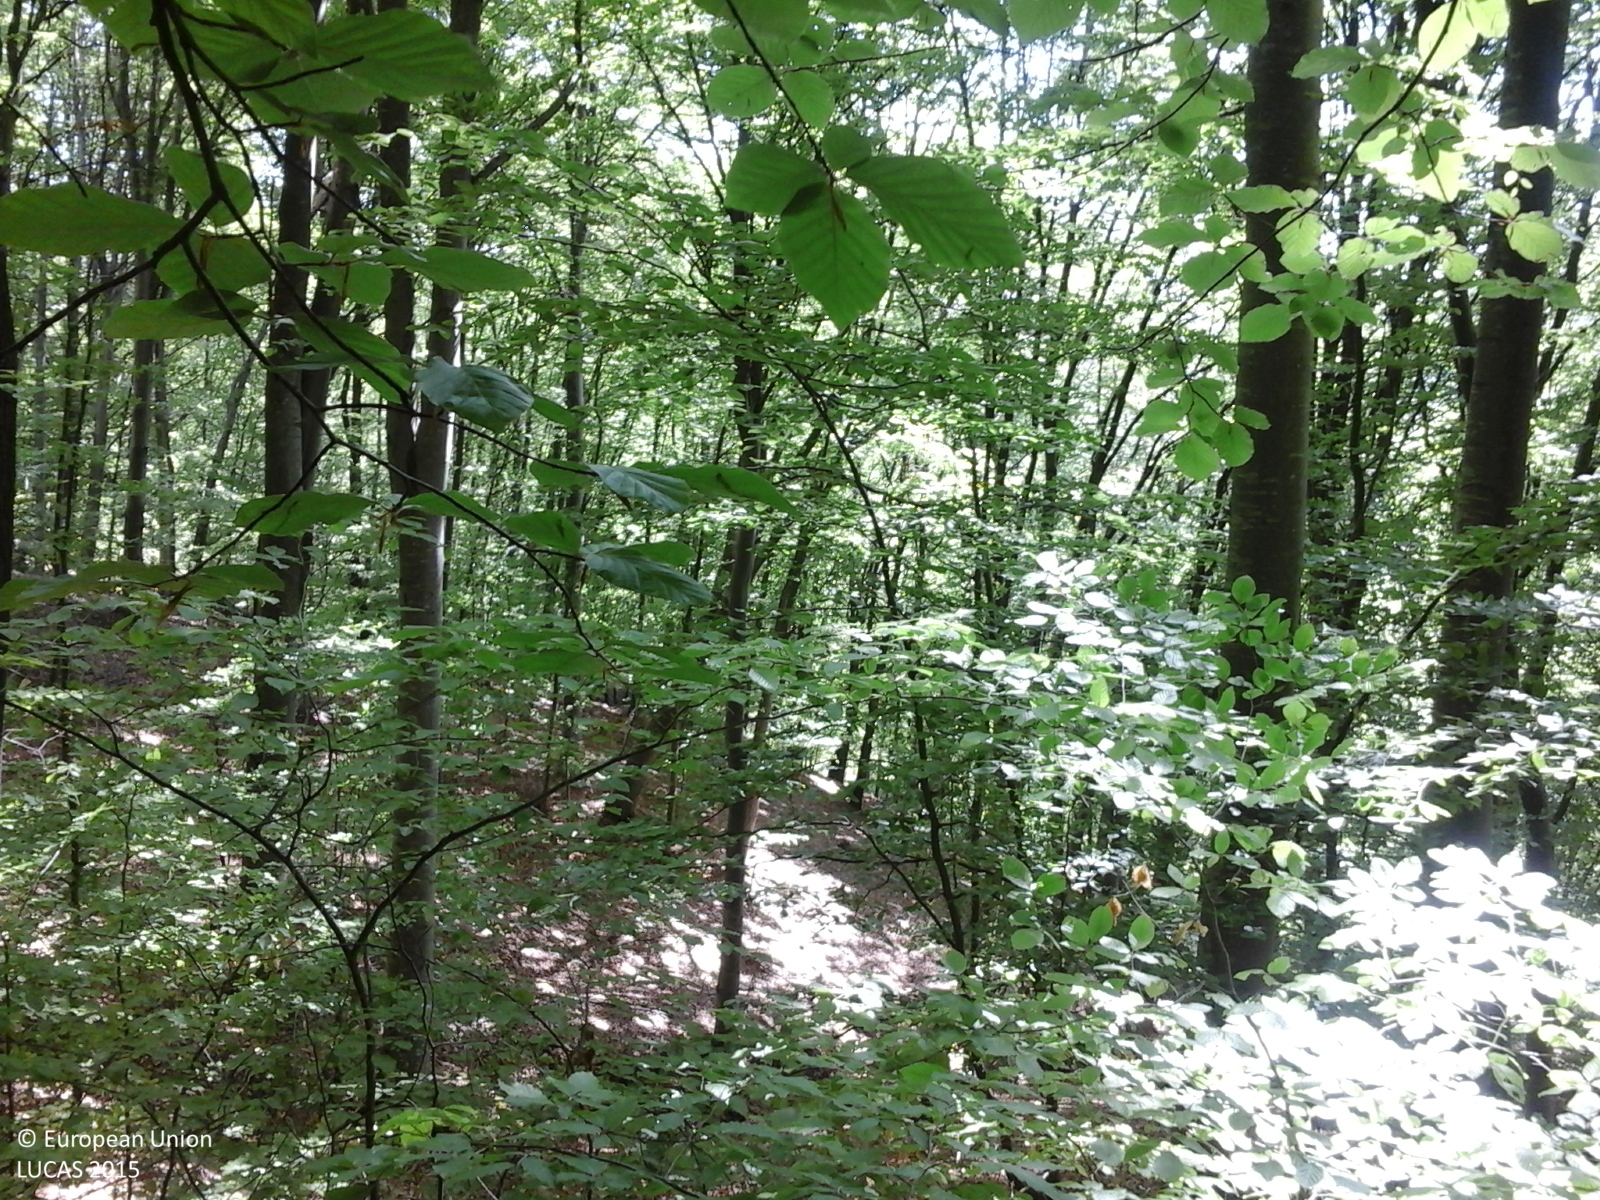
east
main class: Woodland
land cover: Broadleaved woodland
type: beech forest
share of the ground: > 75 %
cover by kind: broadleaved forest trees 100 %
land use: Forestry
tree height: > 5 m
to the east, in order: Broadleaved woodland; Grassland with sparse tree/shrub cover
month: May
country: RO
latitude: 45.8563
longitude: 25.7317
